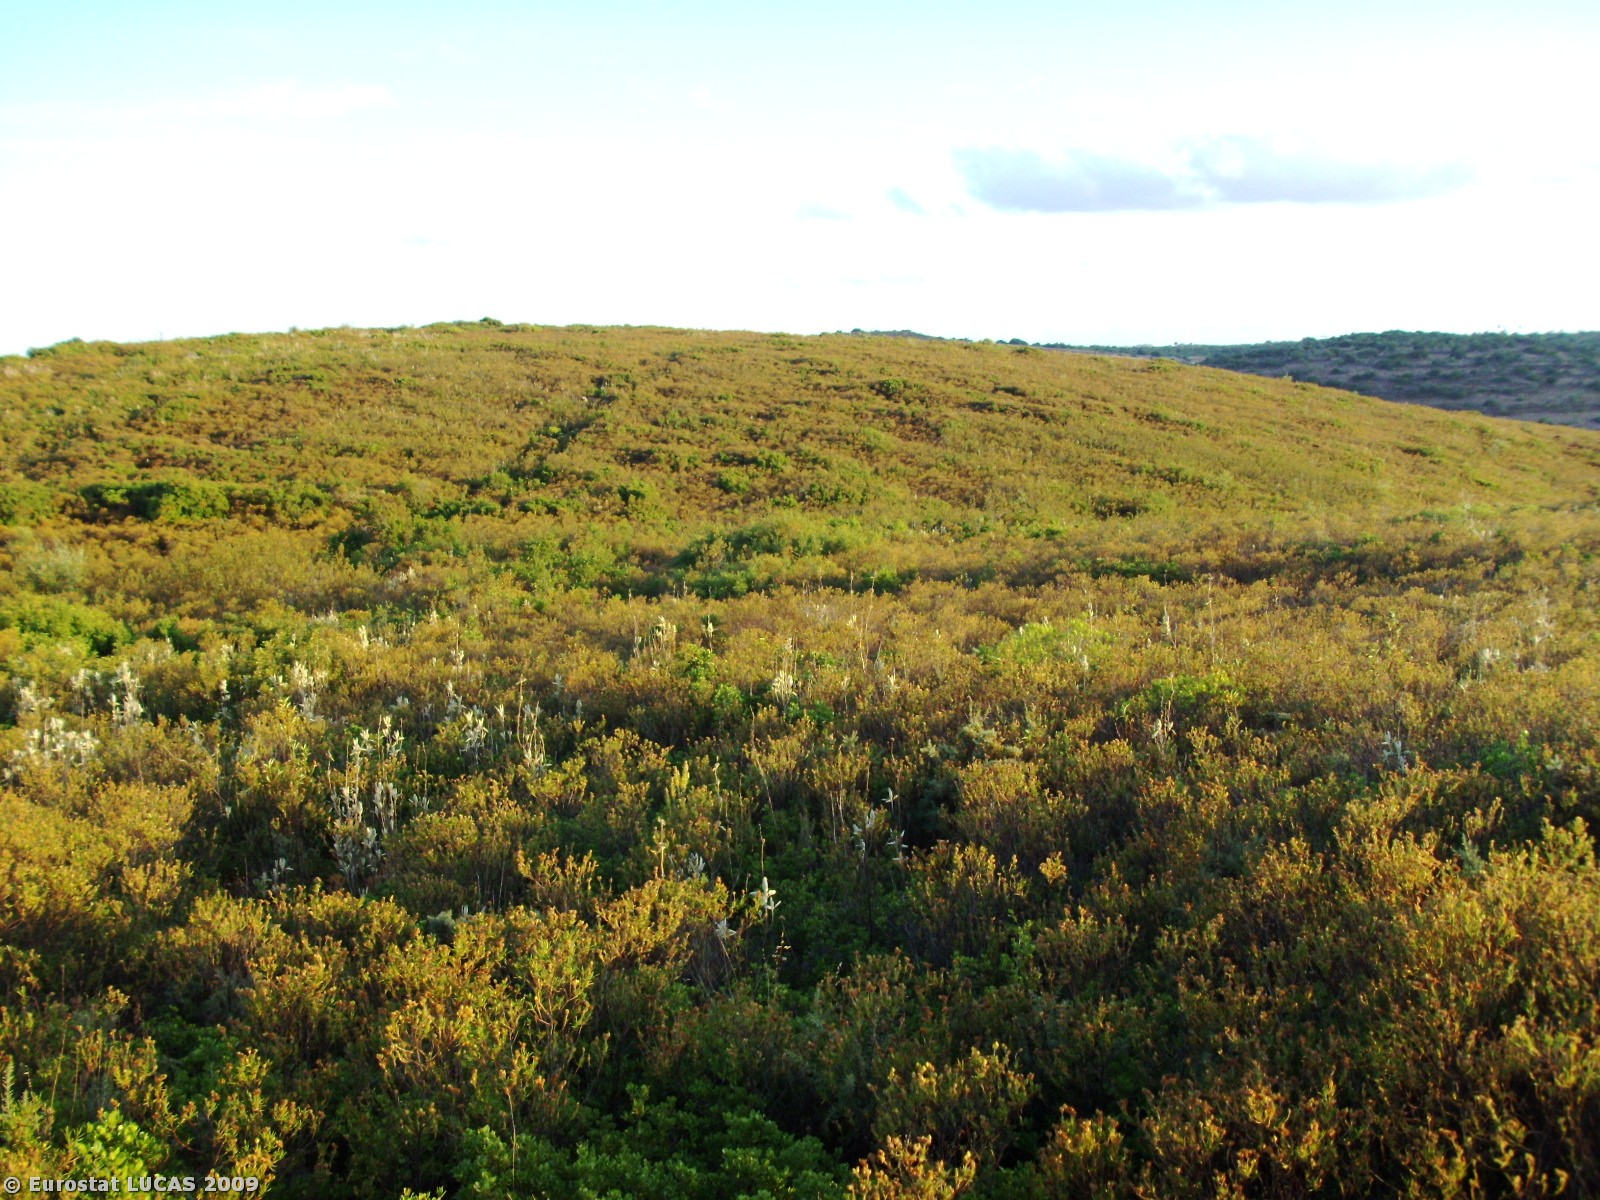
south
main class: Shrubland
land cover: Shrubland without tree cover
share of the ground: > 75 %
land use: Unused
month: June
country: PT
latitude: 37.1523
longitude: -8.7096
